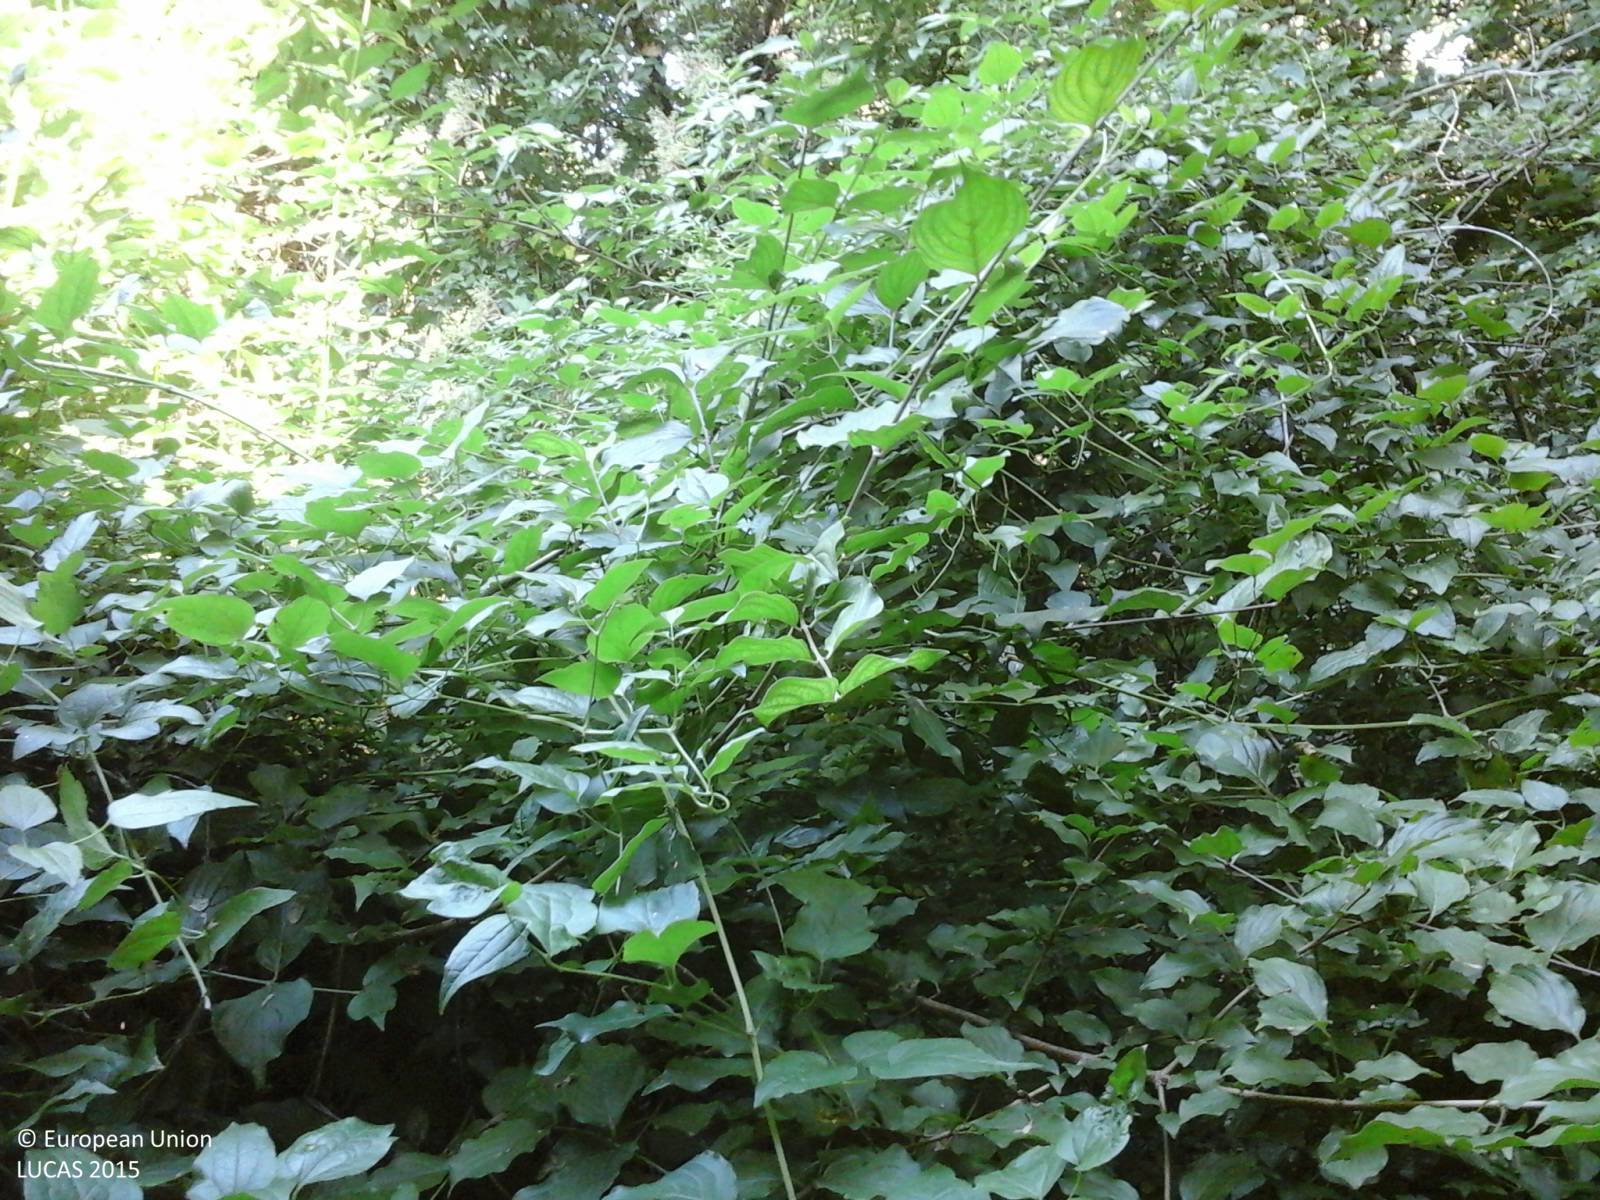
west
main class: Woodland
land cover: Broadleaved woodland
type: thermophilous deciduous forest
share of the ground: > 75 %
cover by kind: broadleaved forest trees 70 %, shrubs 30 %
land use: Semi-natural and natural areas not in use
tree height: > 5 m
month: July
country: IT
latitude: 42.4036
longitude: 13.2336
